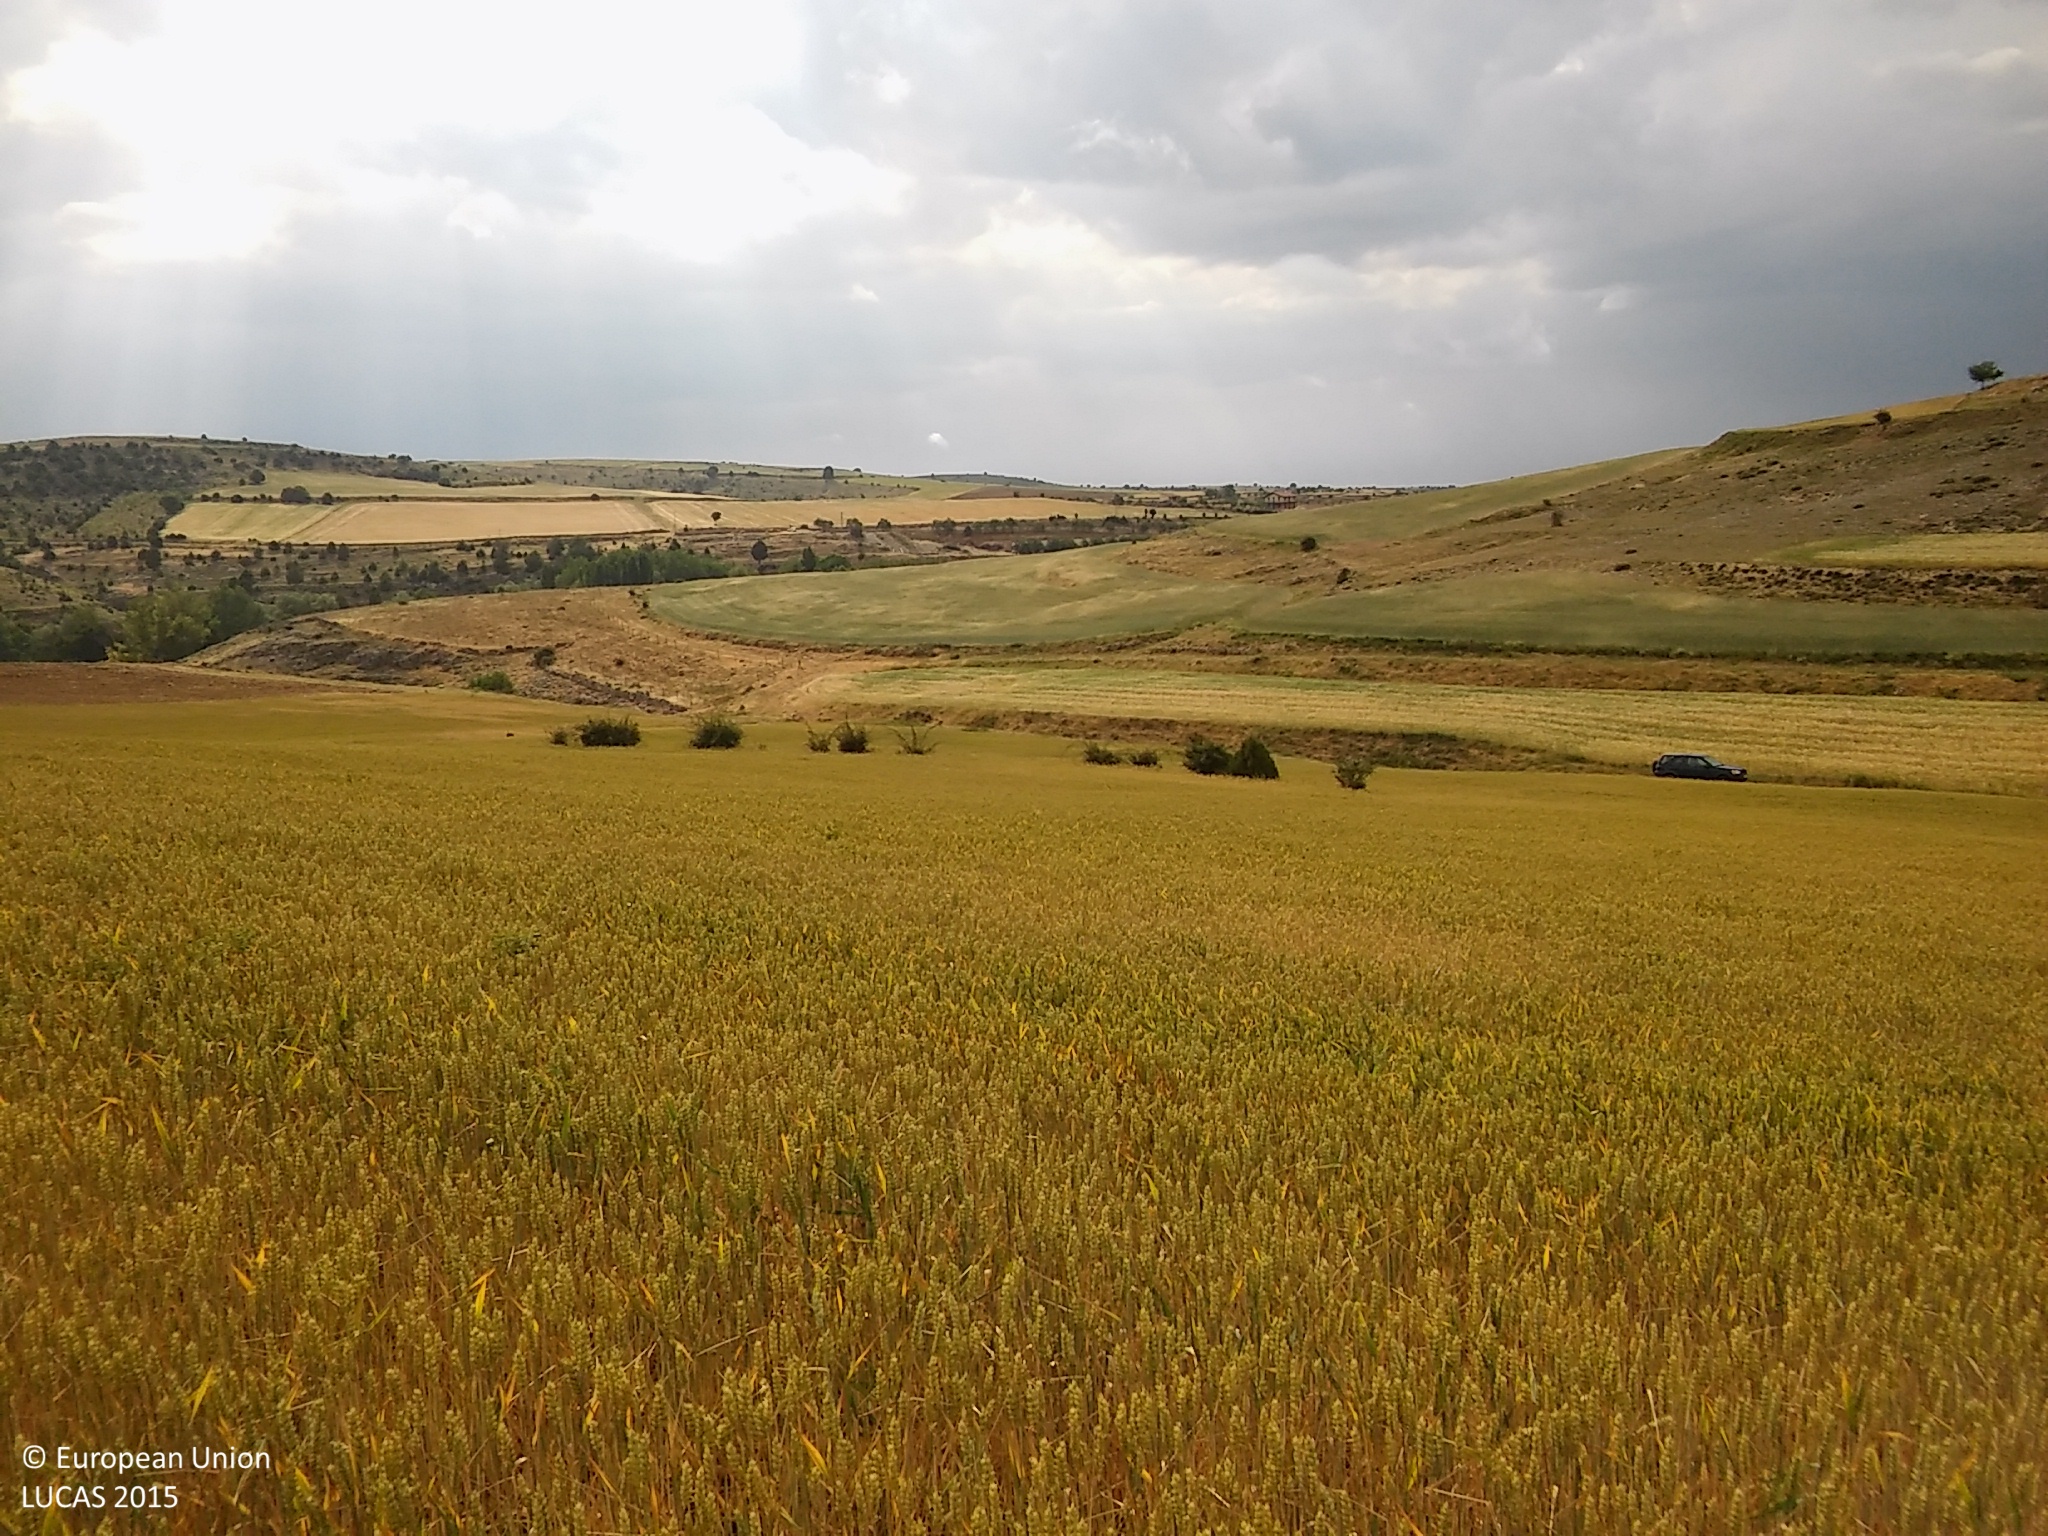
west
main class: Cropland
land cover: Common wheat
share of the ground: > 75 %
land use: Agriculture (excluding fallow land and kitchen gardens)
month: June
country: ES
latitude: 41.2023
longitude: -3.7257
